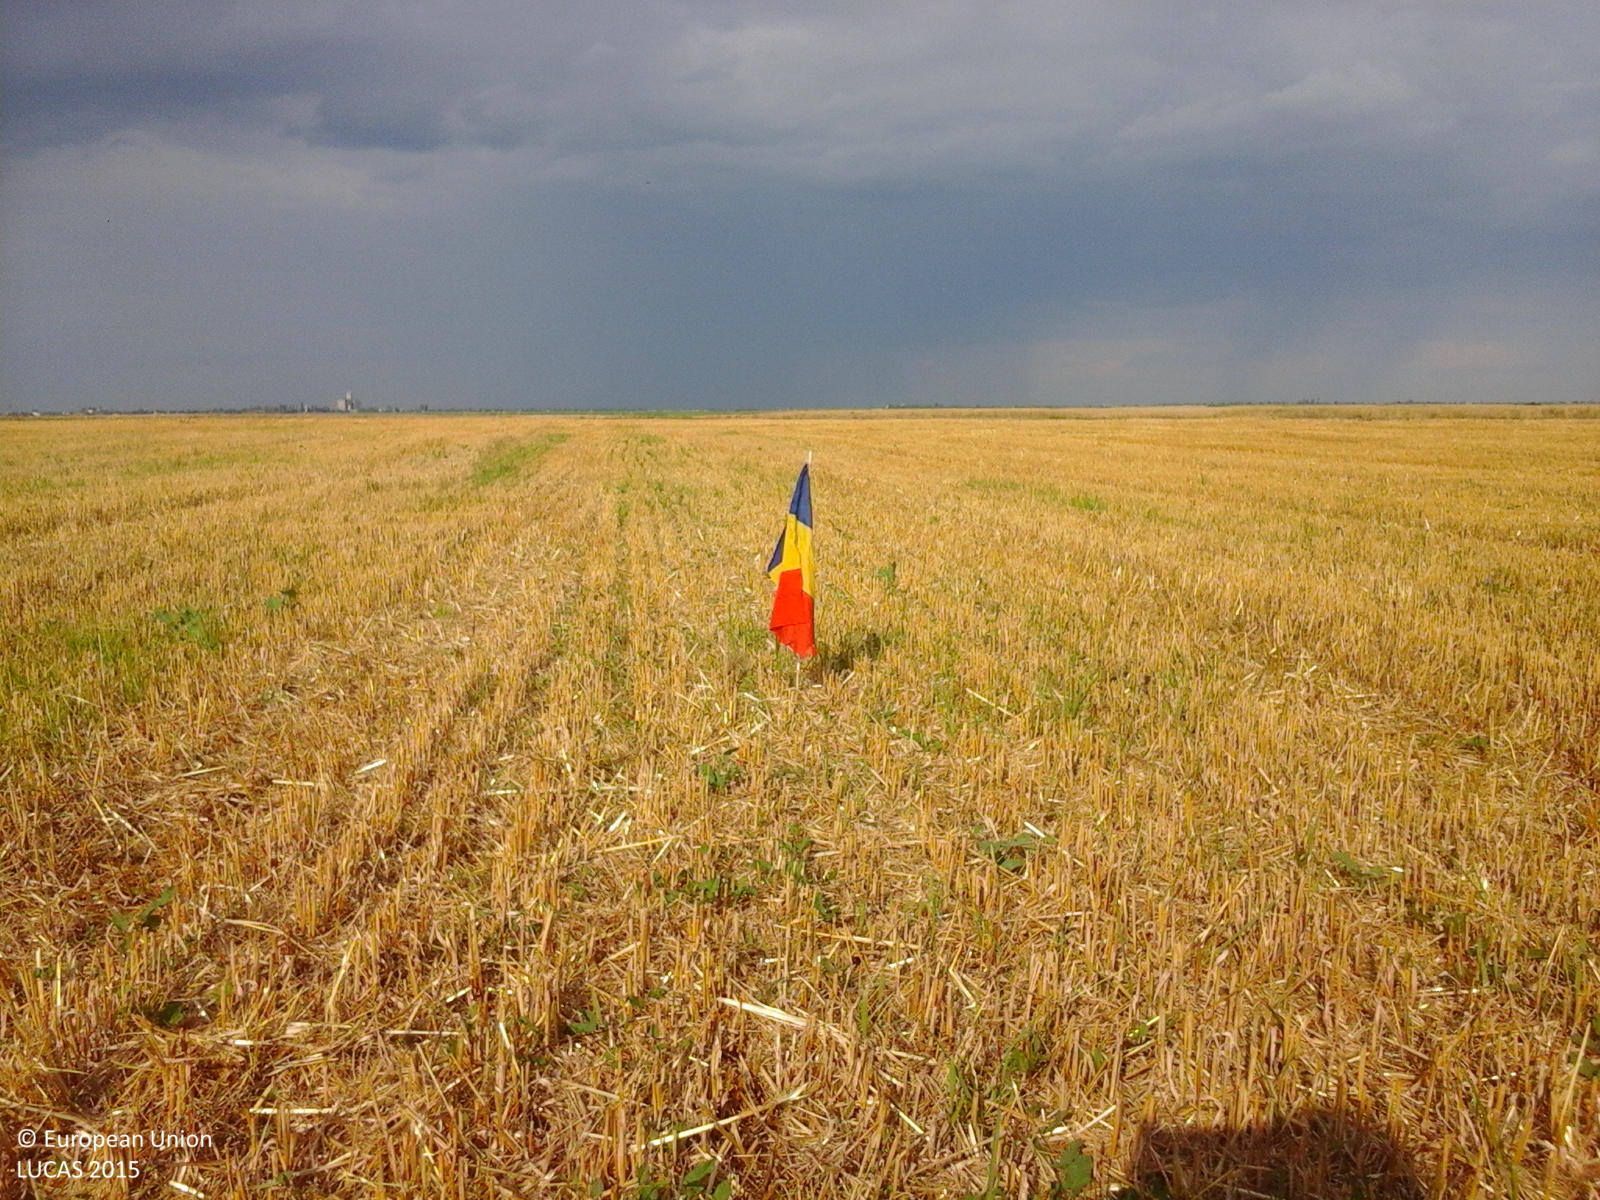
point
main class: Cropland
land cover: Barley
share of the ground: < 10 %
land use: Agriculture (excluding fallow land and kitchen gardens)
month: July
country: RO
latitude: 44.0954
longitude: 24.6216
